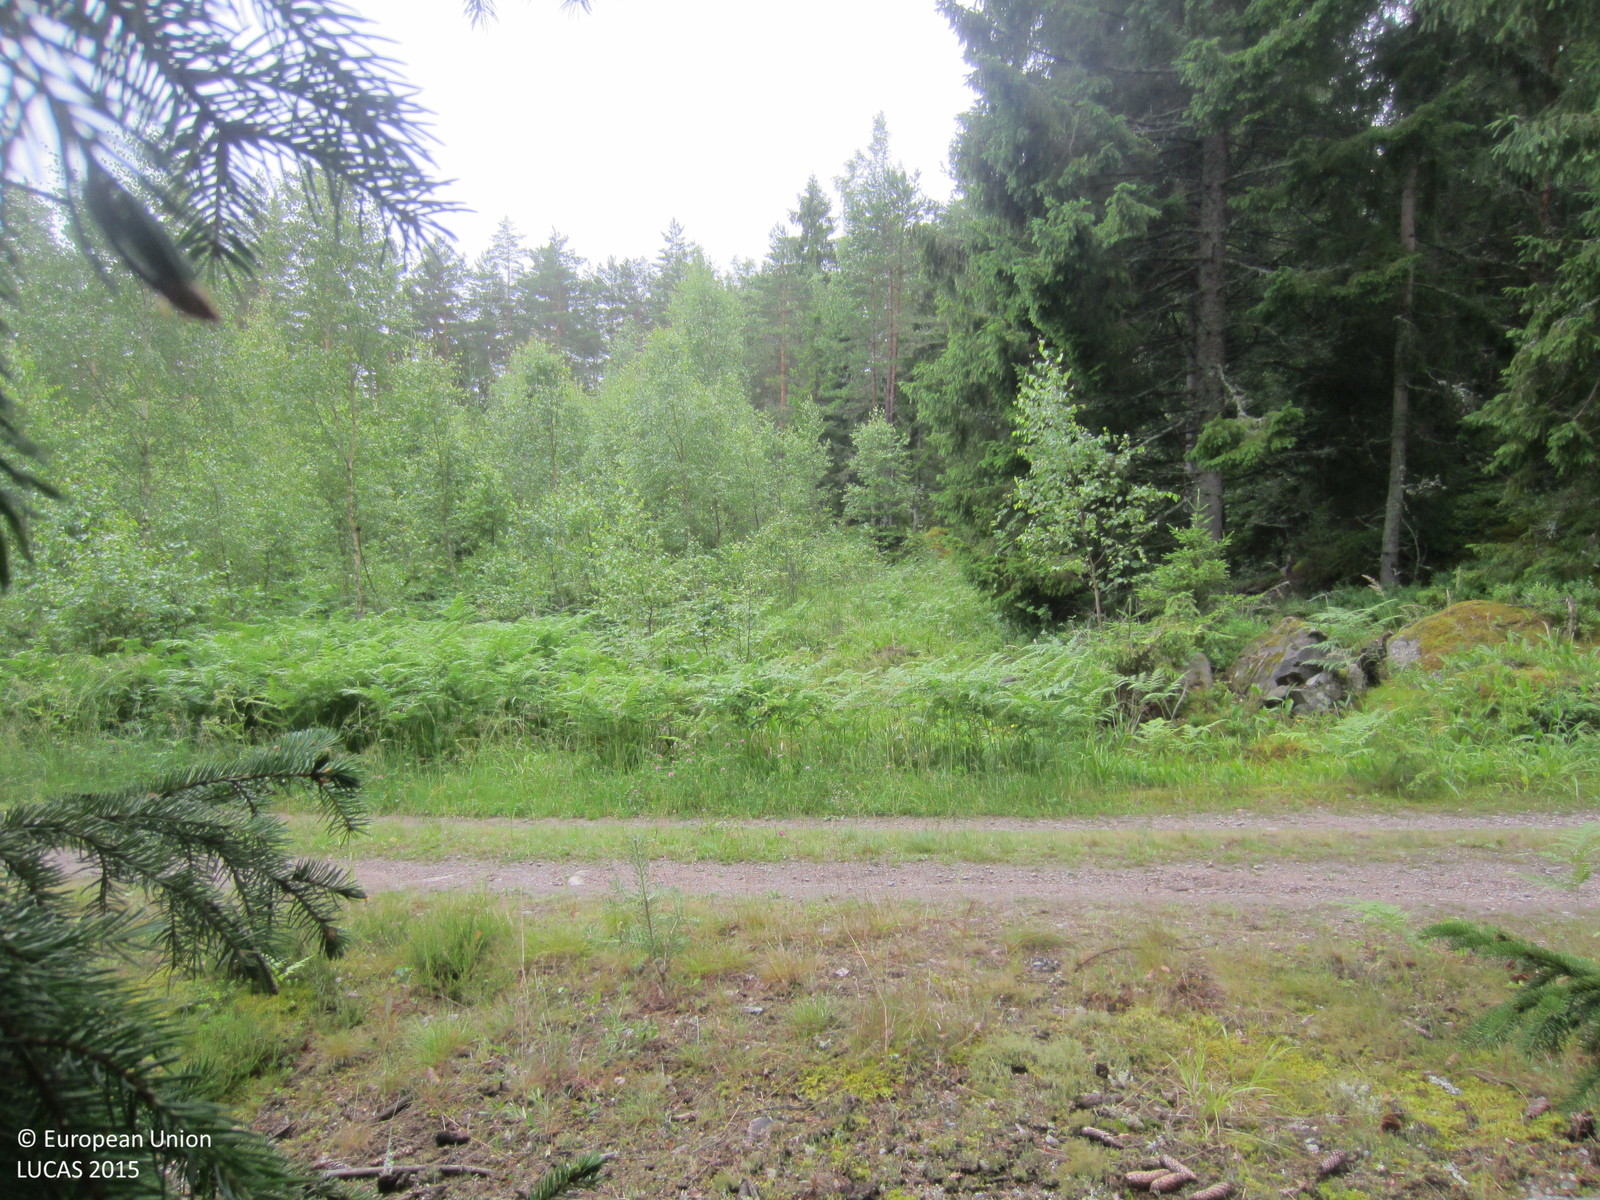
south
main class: Woodland
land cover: Spruce dominated coniferous woodland
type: boreal forest
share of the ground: 50 - 75 %
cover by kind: coniferous forest trees 70 %, lichens and mosses 25 %, broadleaved forest trees 5 %
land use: Forestry
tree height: > 5 m
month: July
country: SE
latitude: 59.8456
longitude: 16.9705
